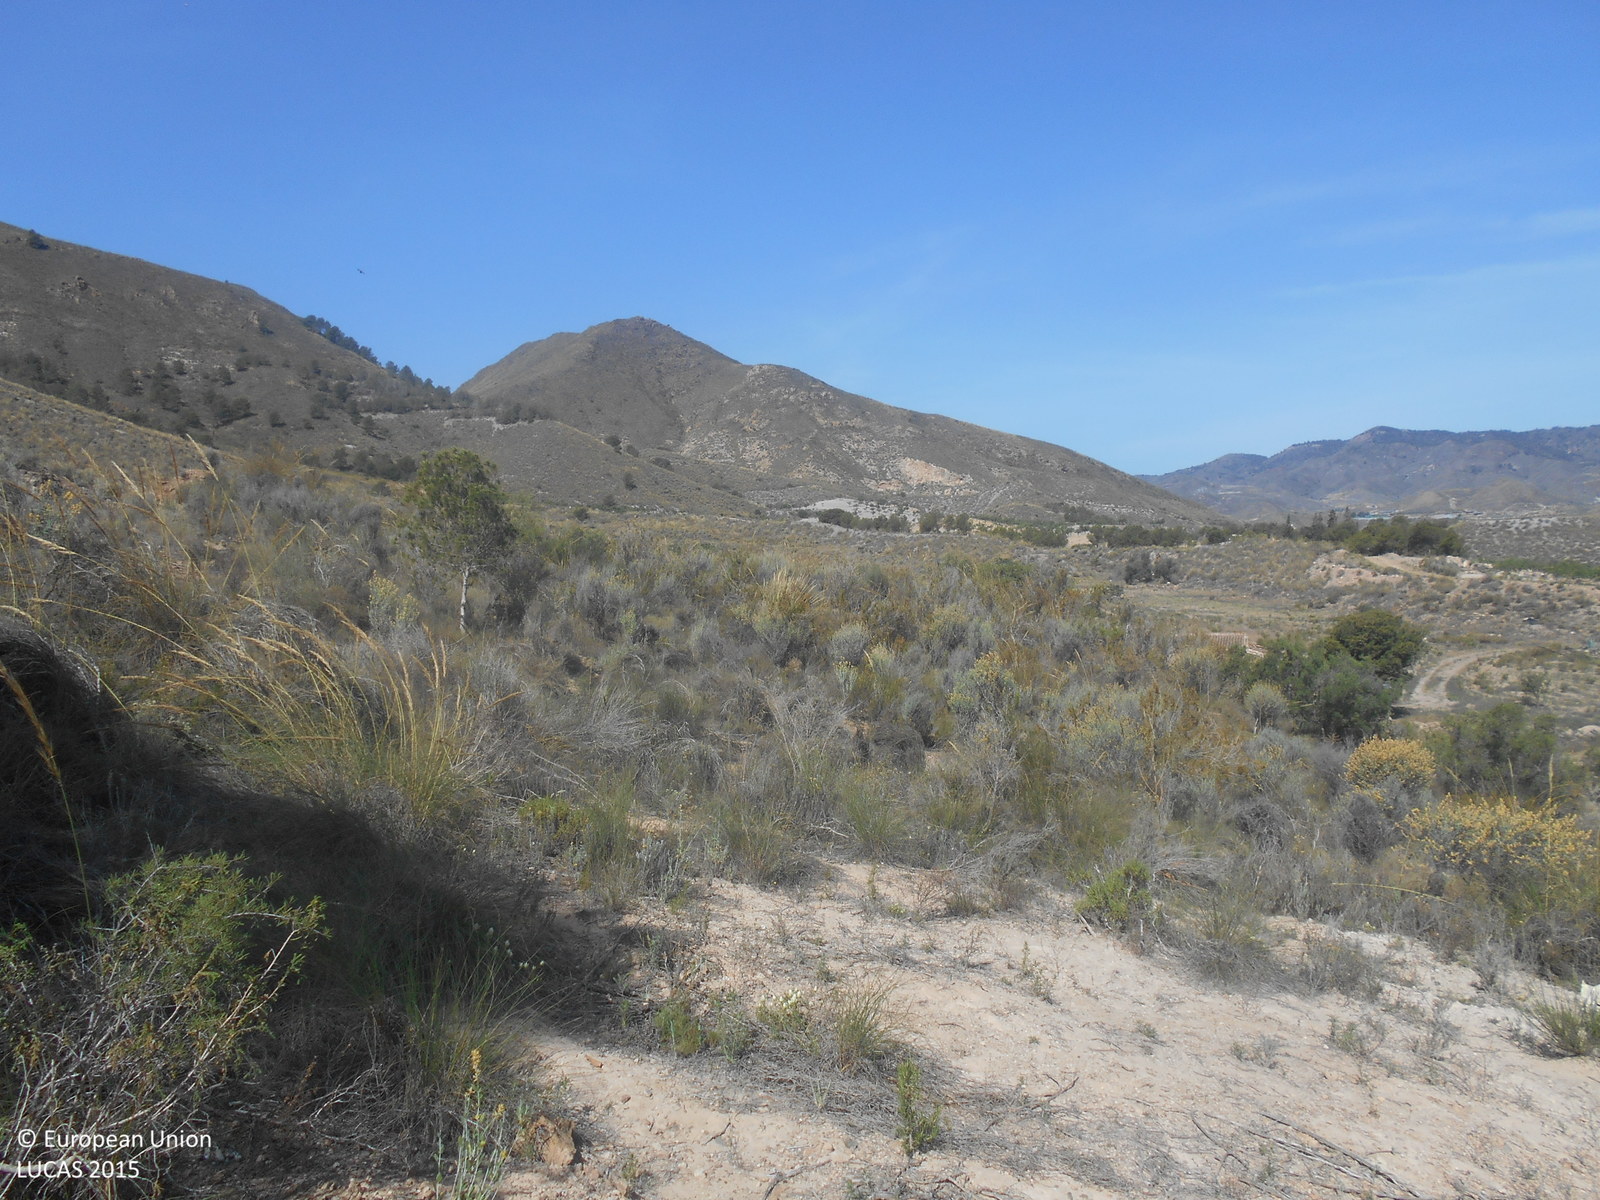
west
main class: Woodland
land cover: Pine dominated coniferous woodland
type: coniferous forest of the mediterranean region
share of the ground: 10 - 25 %
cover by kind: shrubs 60 %, coniferous forest trees 20 %, herbaceous plants 10 %, unconsolidated bare surface 10 %
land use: Semi-natural and natural areas not in use
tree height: > 5 m
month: May
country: ES
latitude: 37.6046
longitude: -1.4323
